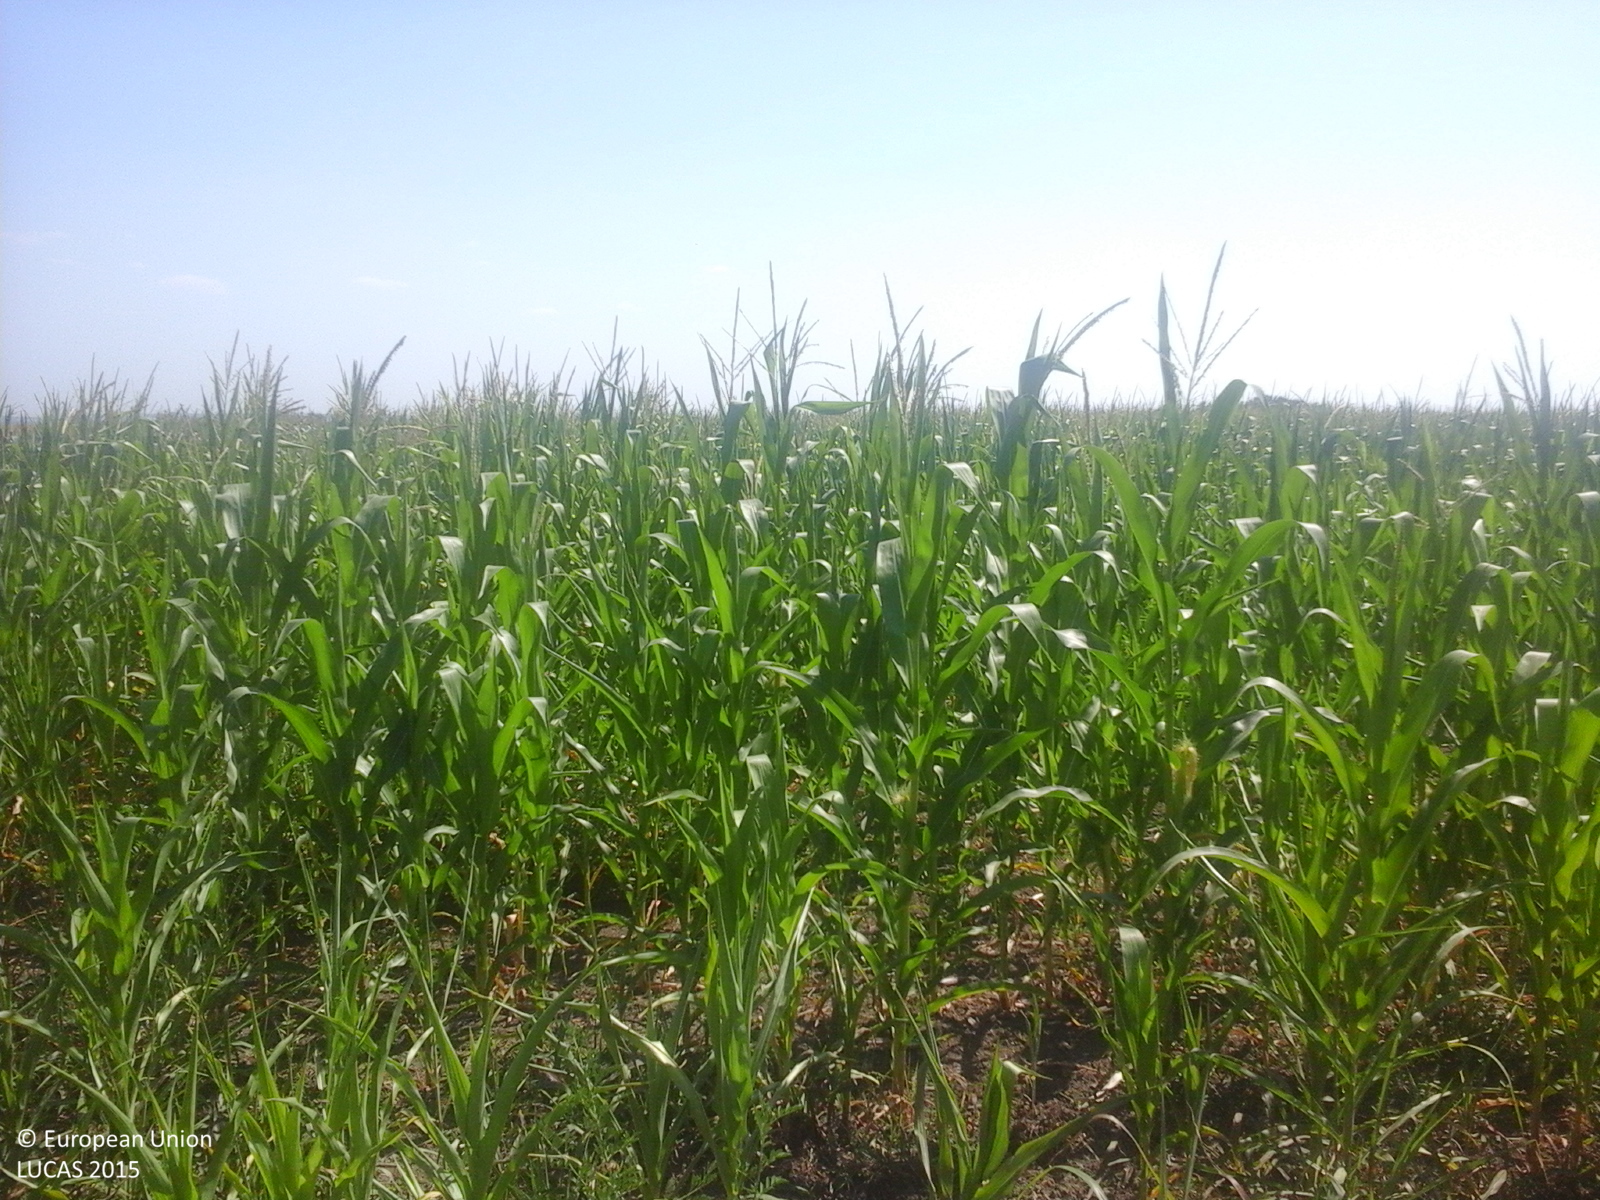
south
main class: Cropland
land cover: Soya
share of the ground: > 75 %
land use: Agriculture (excluding fallow land and kitchen gardens)
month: July
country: RO
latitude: 44.1926
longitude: 27.1835
